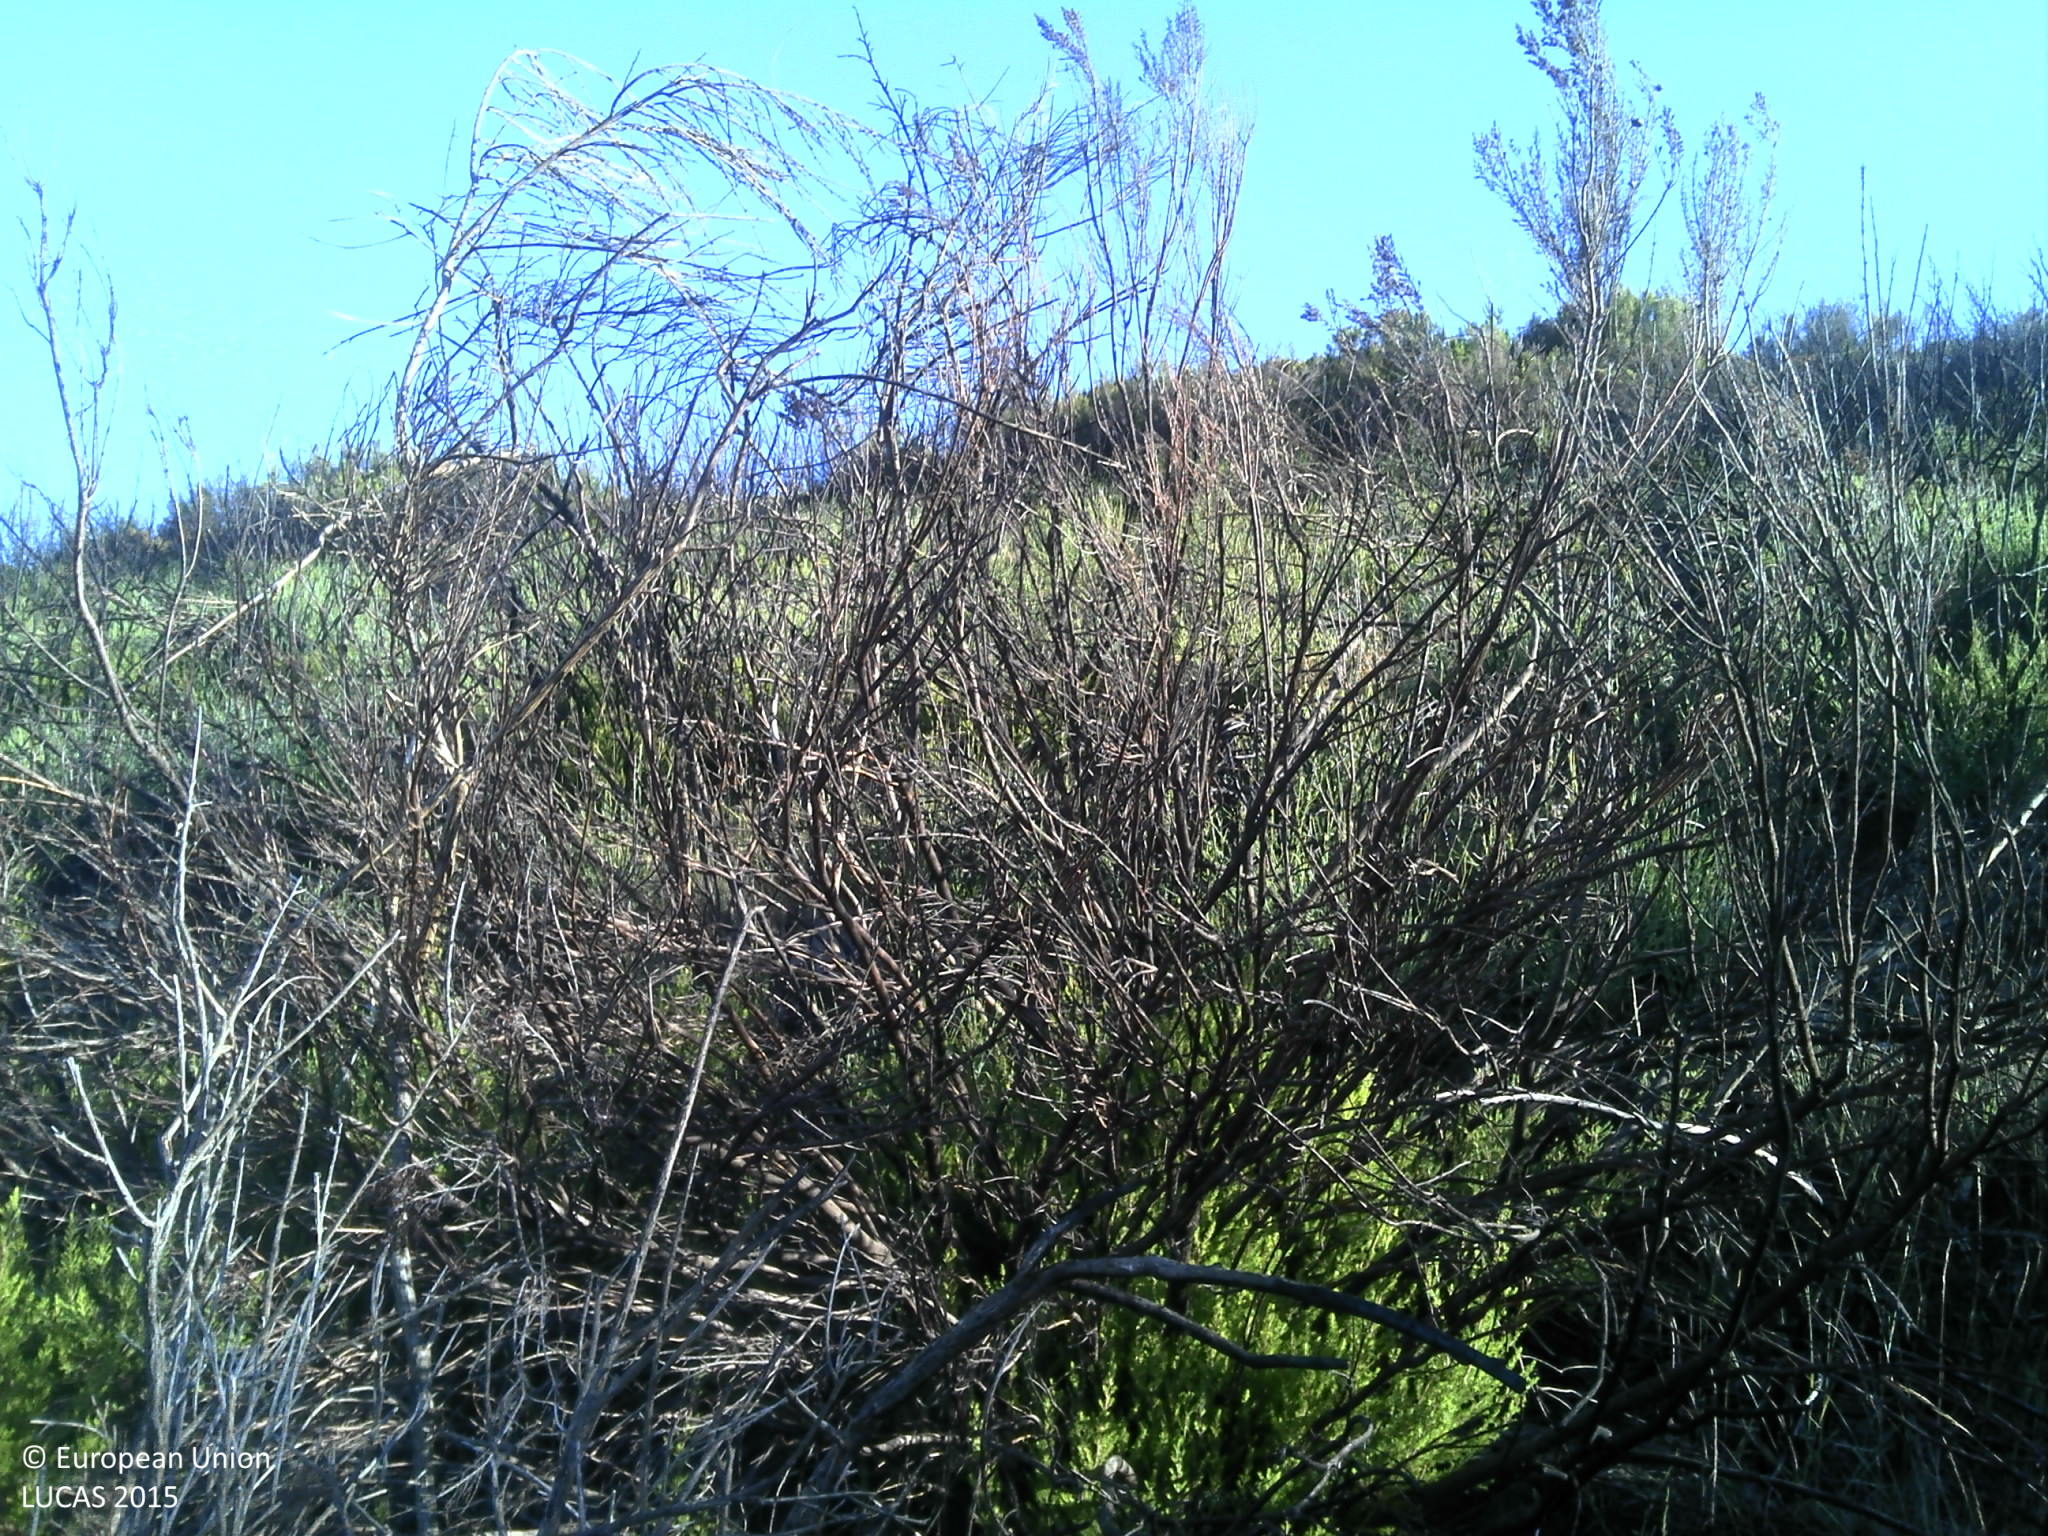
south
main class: Shrubland
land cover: Shrubland without tree cover
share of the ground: > 75 %
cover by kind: shrubs 90 %, unconsolidated bare surface 10 %
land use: Abandoned areas
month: July
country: PT
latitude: 40.4561
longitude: -7.4795
